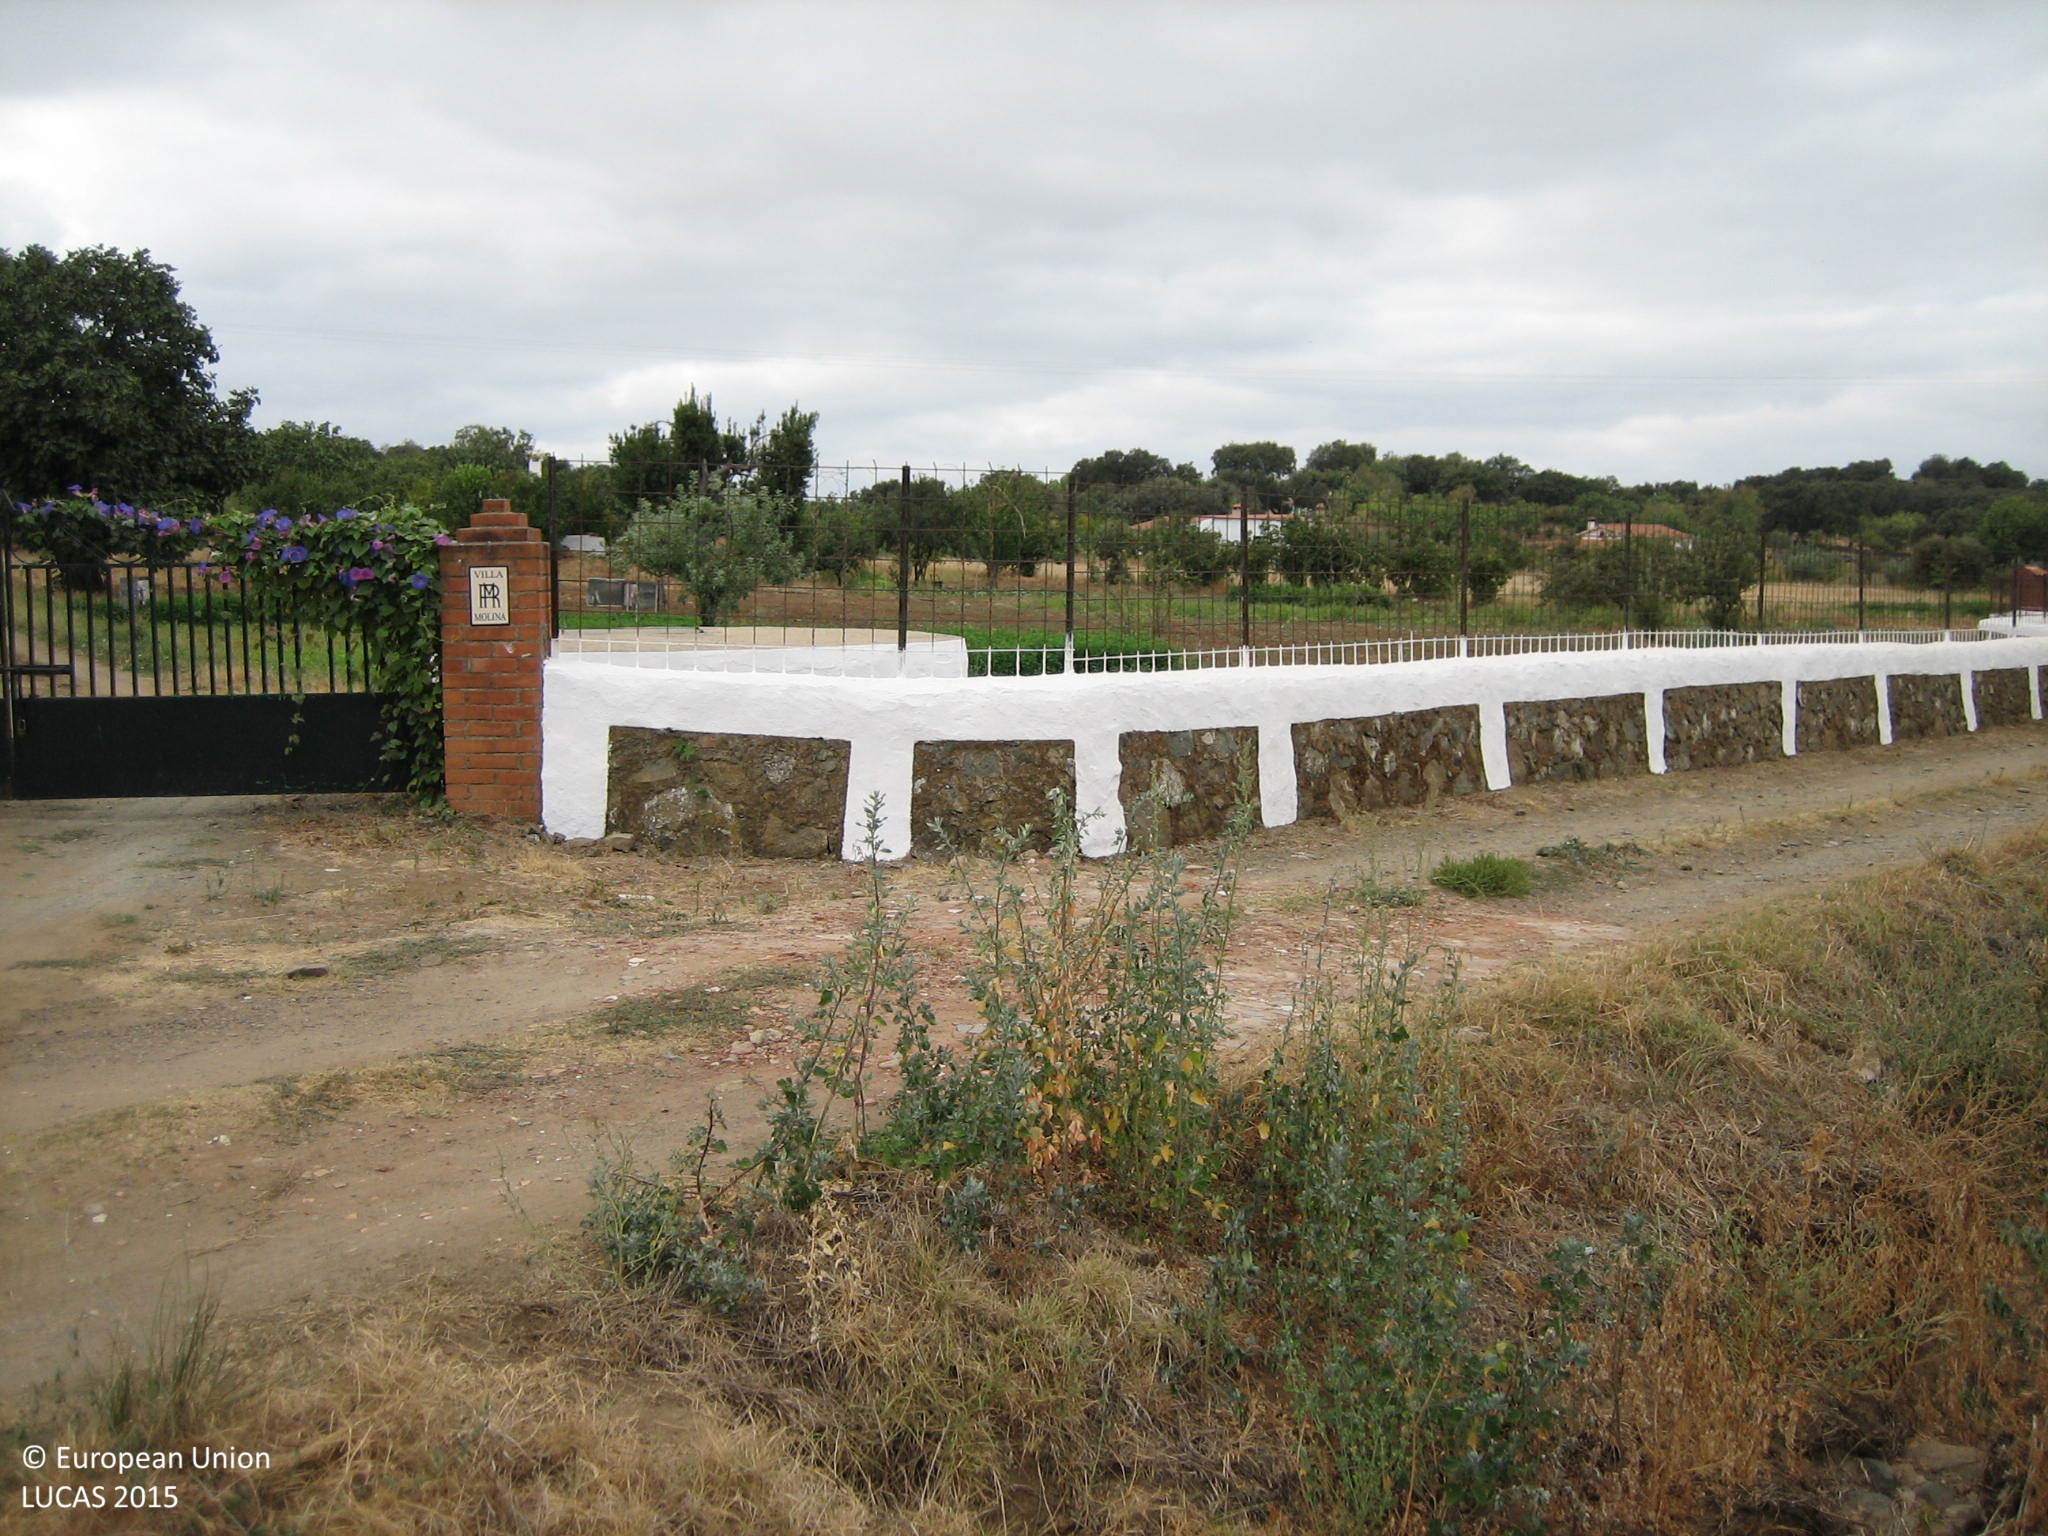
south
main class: Cropland
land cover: Other fruit trees and berries
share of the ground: 25 - 50 %
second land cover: Spontaneously vegetated surfaces
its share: 10 - 25 %
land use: Agriculture (excluding fallow land and kitchen gardens)
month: September
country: ES
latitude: 38.5190
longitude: -6.8636
